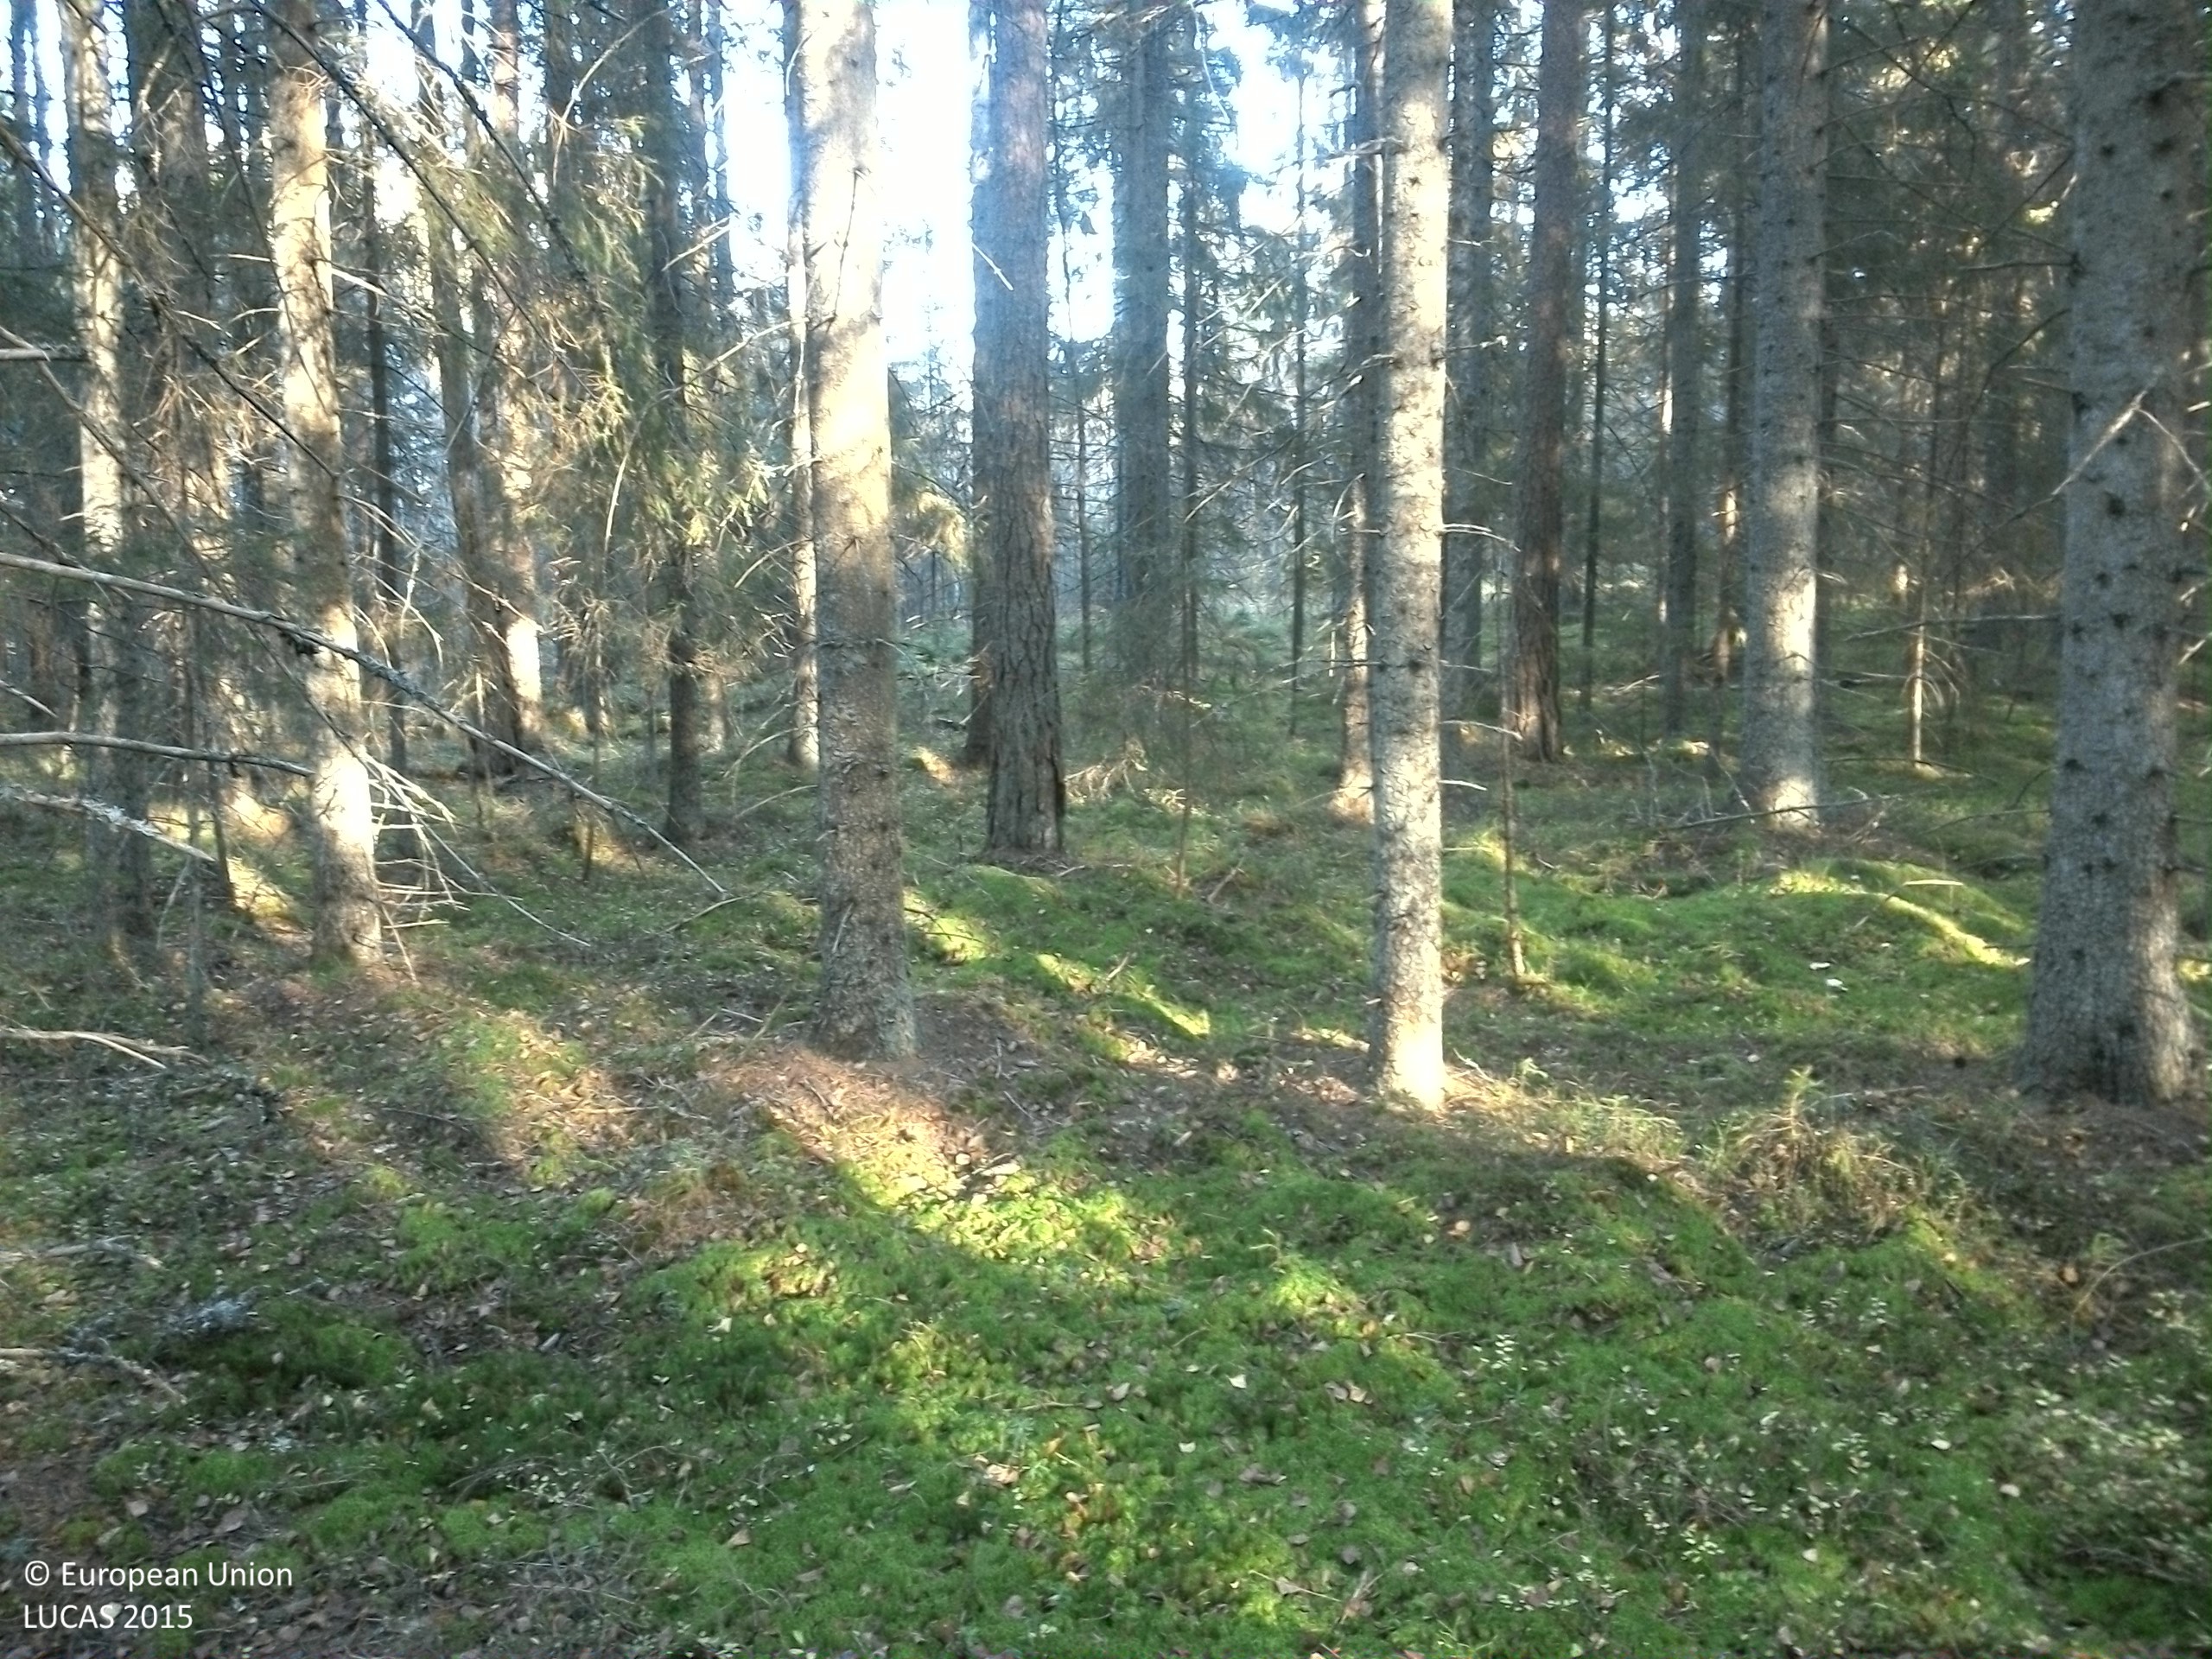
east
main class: Woodland
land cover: Spruce dominated coniferous woodland
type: boreal forest
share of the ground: > 75 %
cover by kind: coniferous forest trees 75 %, shrubs 15 %, lichens and mosses 10 %
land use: Forestry
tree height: > 5 m
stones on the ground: < 10 %
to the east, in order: Spruce dominated coniferous woodland; Pine dominated coniferous woodland; Spruce dominated mixed woodland; Spruce dominated coniferous woodland; Pine dominated coniferous woodland
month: October
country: SE
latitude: 59.5625
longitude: 15.1760
